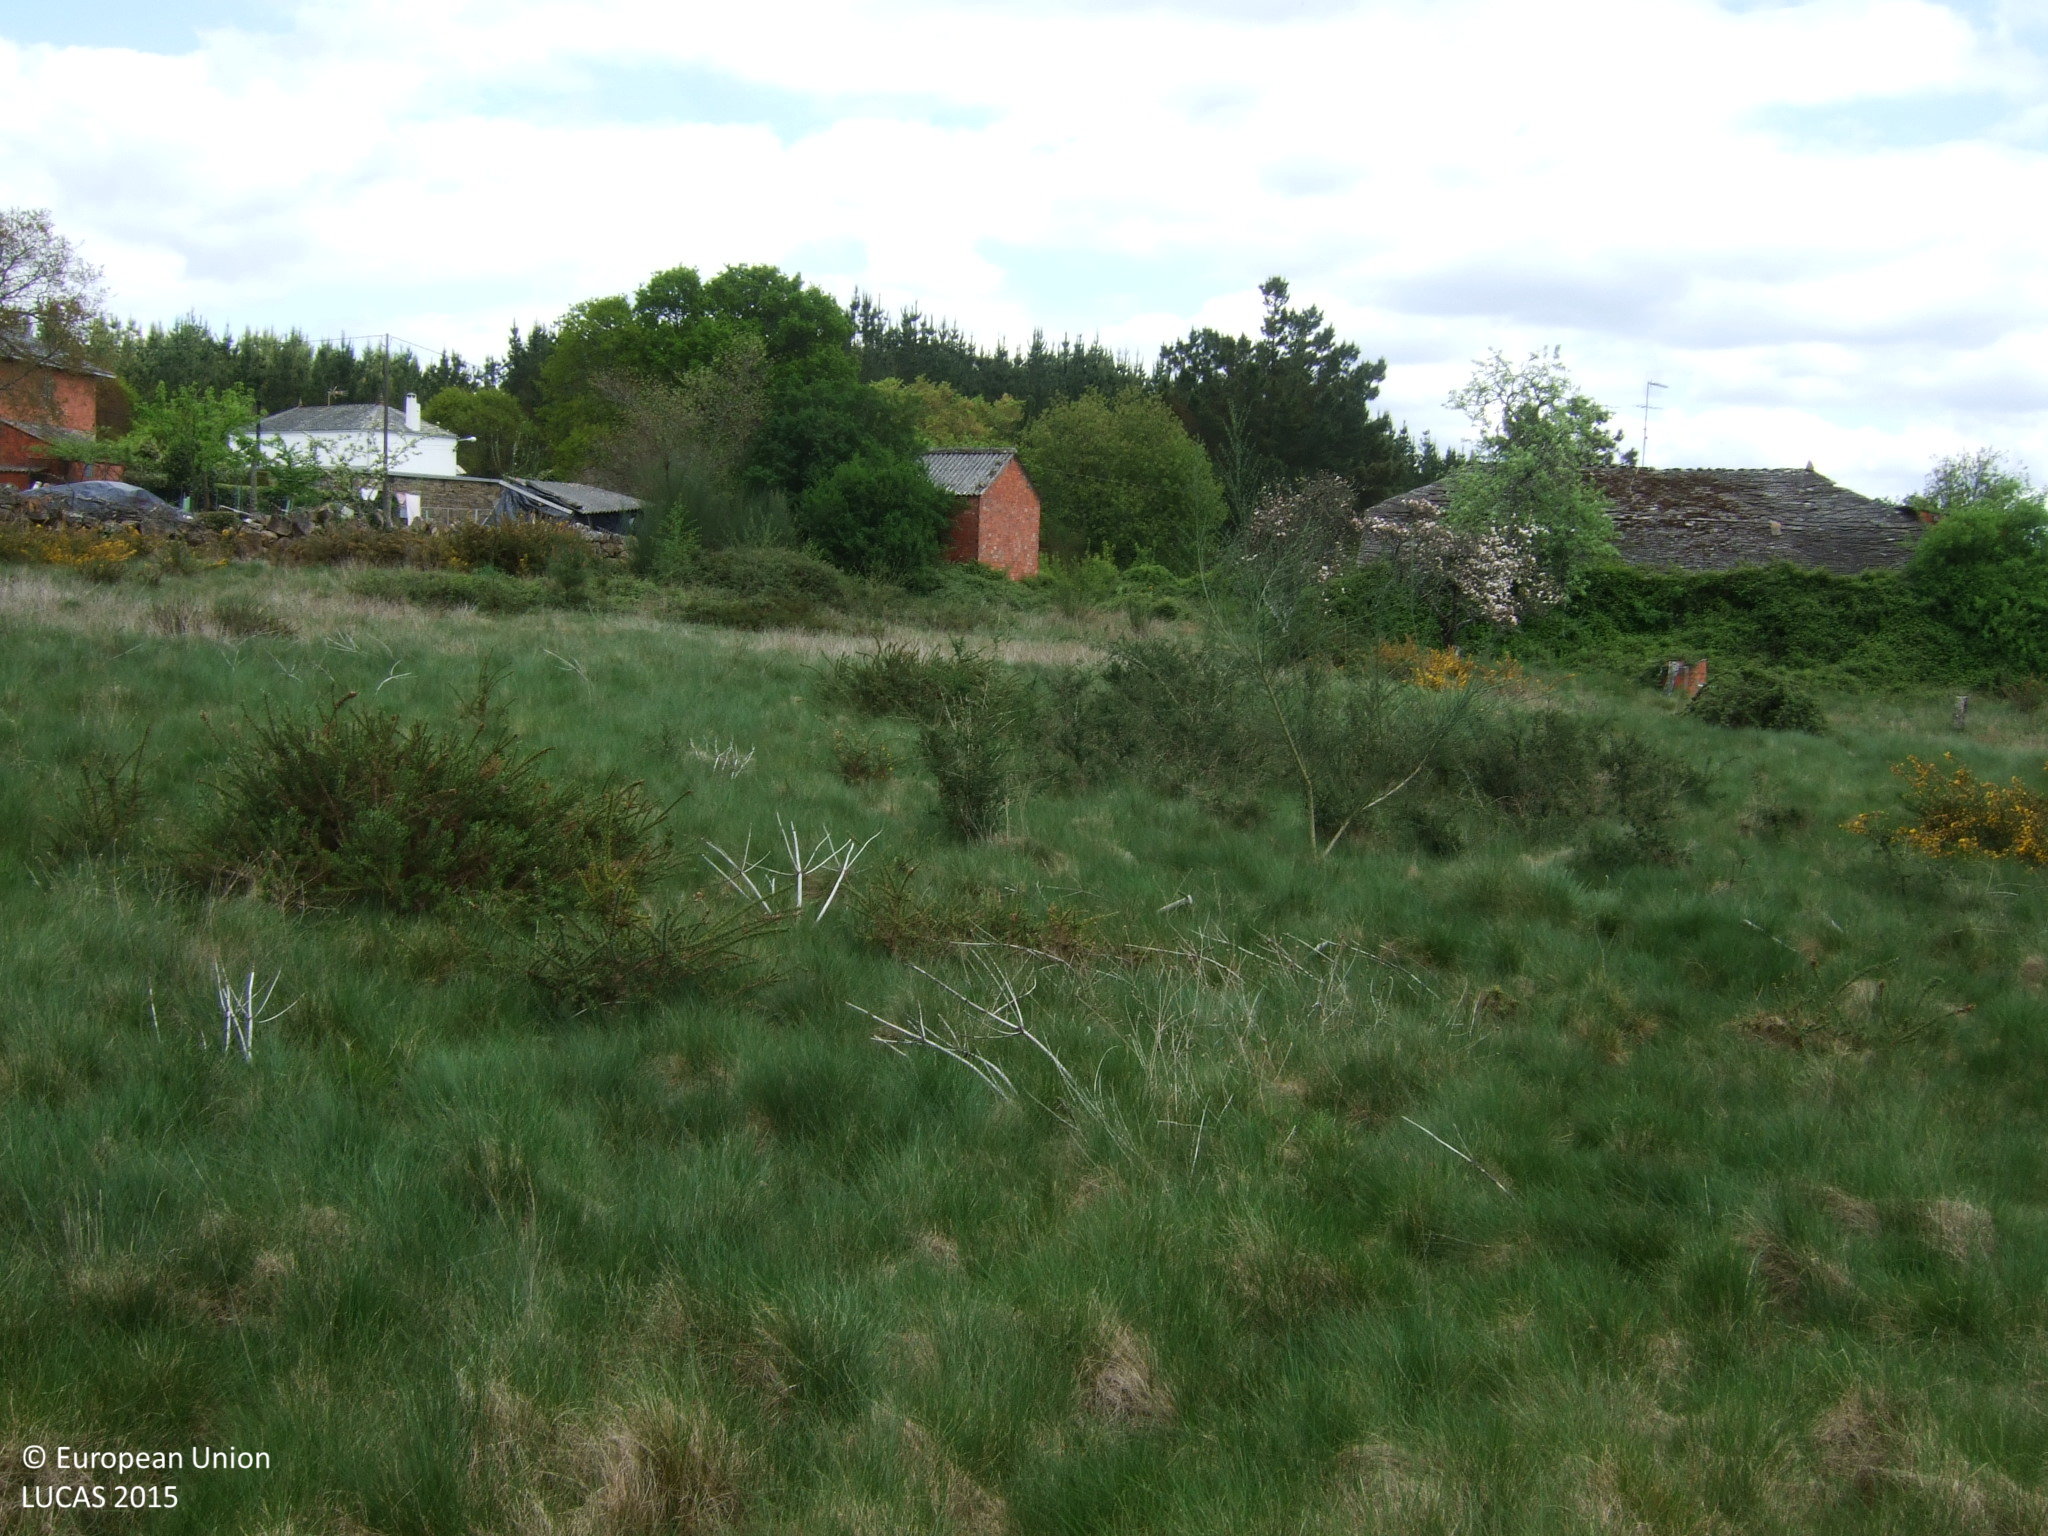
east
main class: Grassland
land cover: Grassland without tree/shrub cover
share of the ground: > 75 %
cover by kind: herbaceous plants 95 %, shrubs 5 %
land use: Semi-natural and natural areas not in use
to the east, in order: Grassland without tree/shrub cover; Electric lines; Grassland without tree/shrub cover; Shrubland with sparse tree cover; Dry stone walls; Grassland with sparse tree/shrub cover; Electric lines; Paved roads, cycling and walking lanes; Electric lines; Grassland without tree/shrub cover; Dry stone walls; Pine dominated coniferous woodland
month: April
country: ES
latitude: 43.1279
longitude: -7.6974
